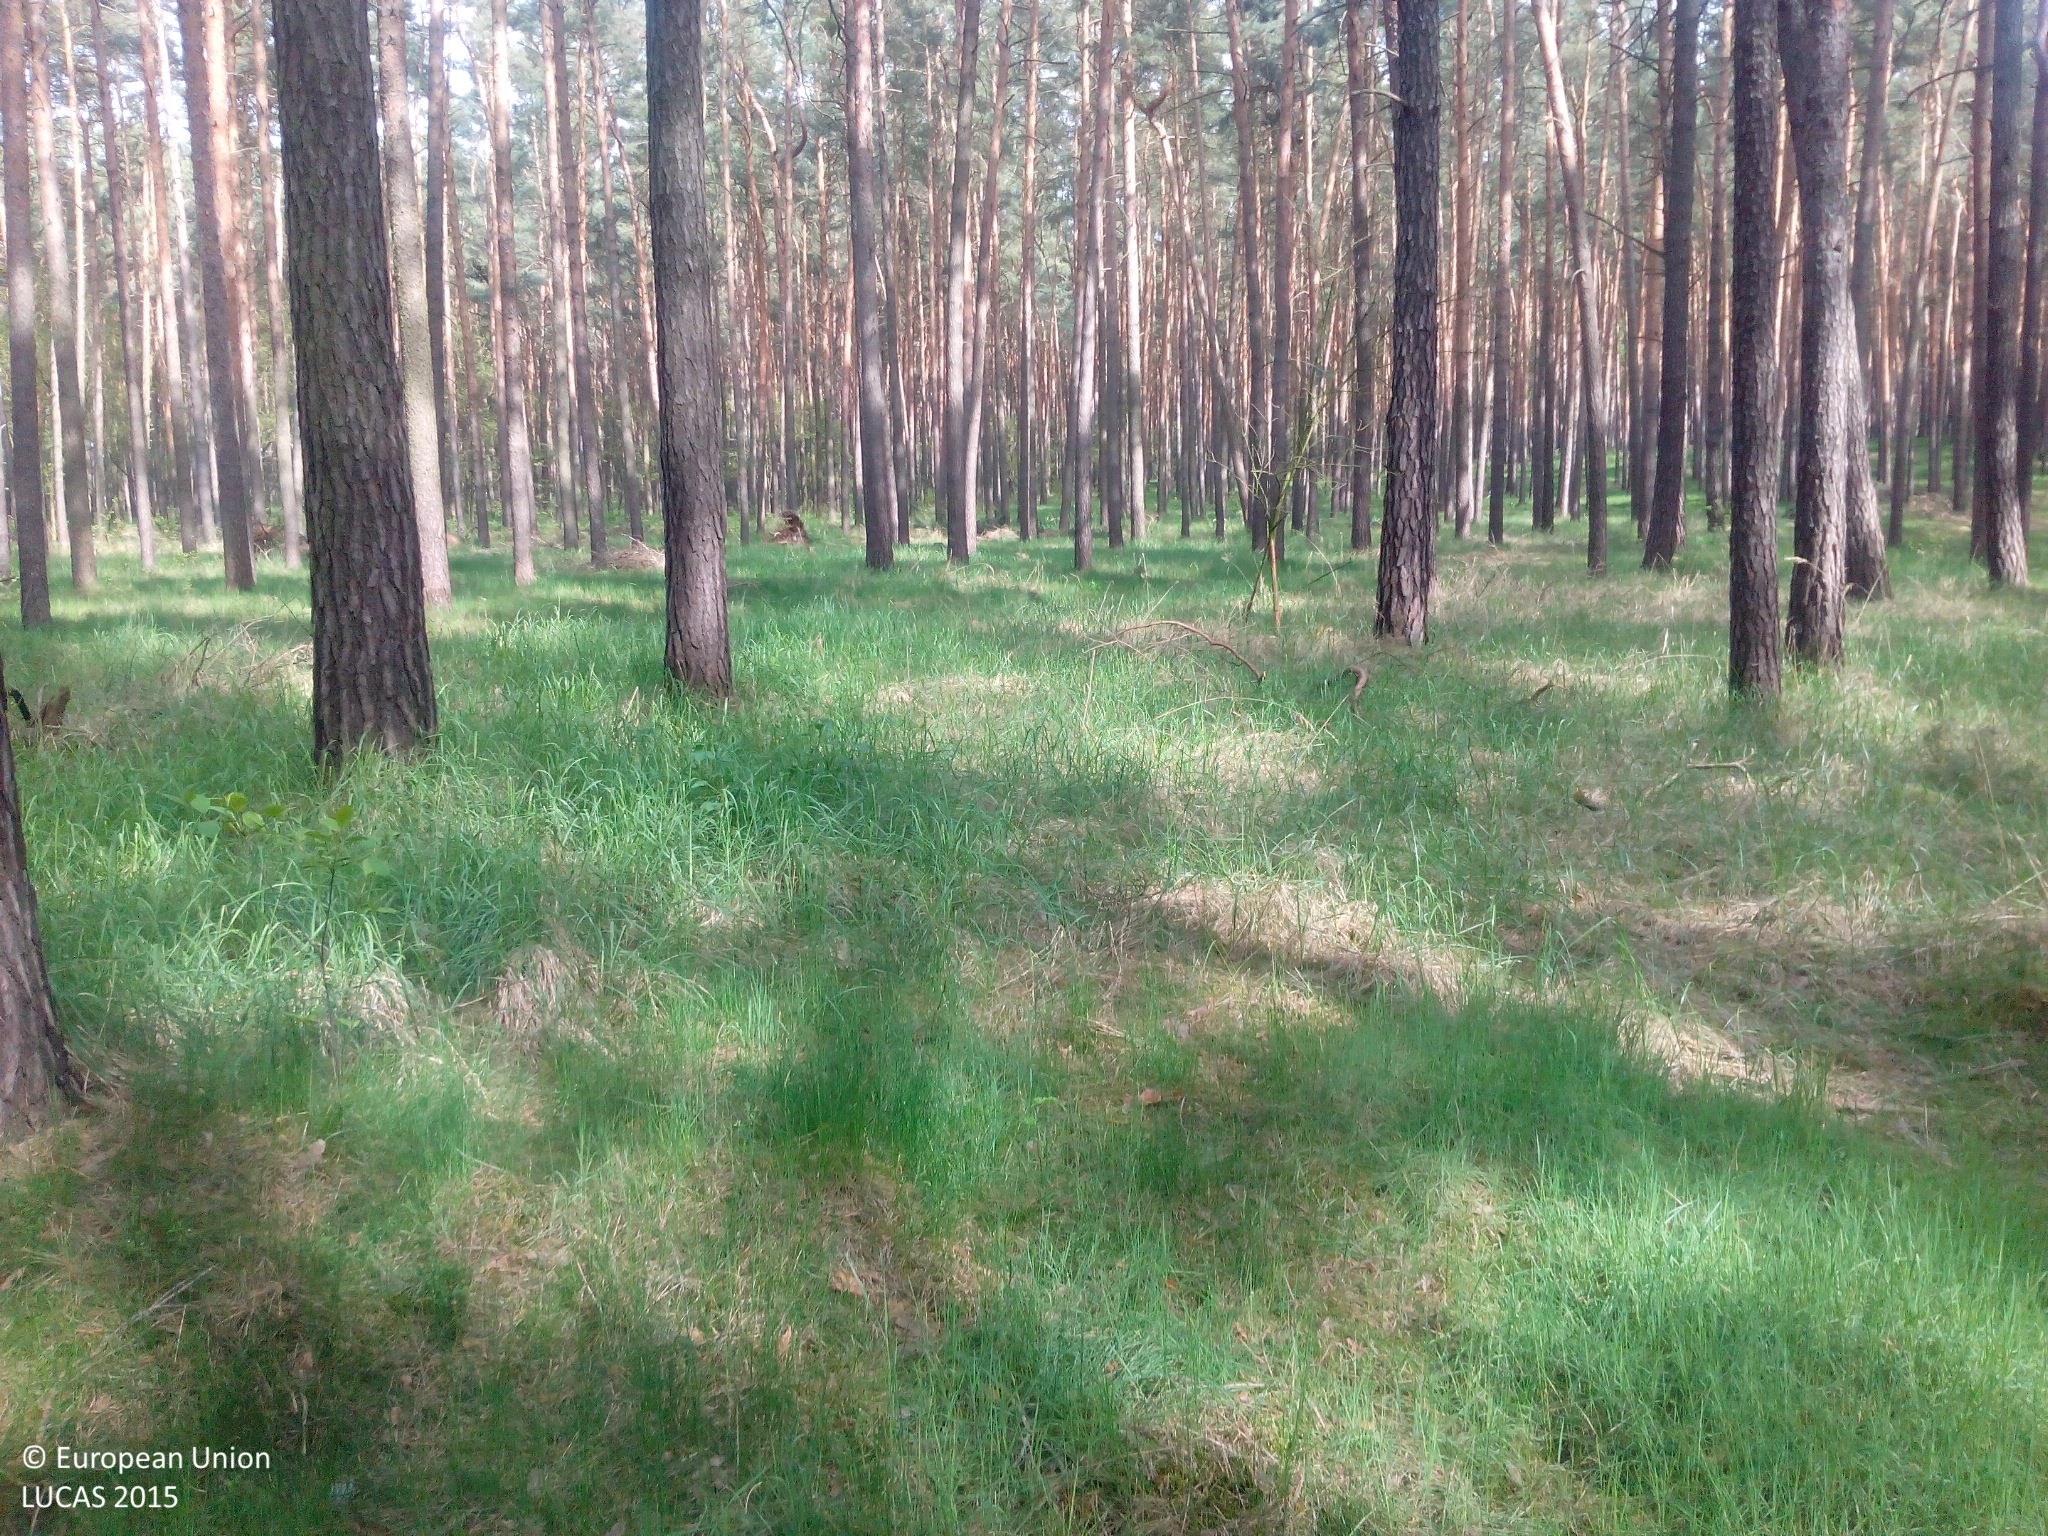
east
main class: Woodland
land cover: Pine dominated coniferous woodland
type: hemiboreal forest and nemoral coniferous forest and mixed broadleaved-coniferous forest
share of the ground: > 75 %
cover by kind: coniferous forest trees 100 %
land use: Forestry
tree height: > 5 m
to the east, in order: Pine dominated coniferous woodland; Tracks; Pine dominated coniferous woodland; Tracks; Pine dominated coniferous woodland; Tracks; Pine dominated coniferous woodland
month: May
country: DE
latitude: 51.8923
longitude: 13.5605
